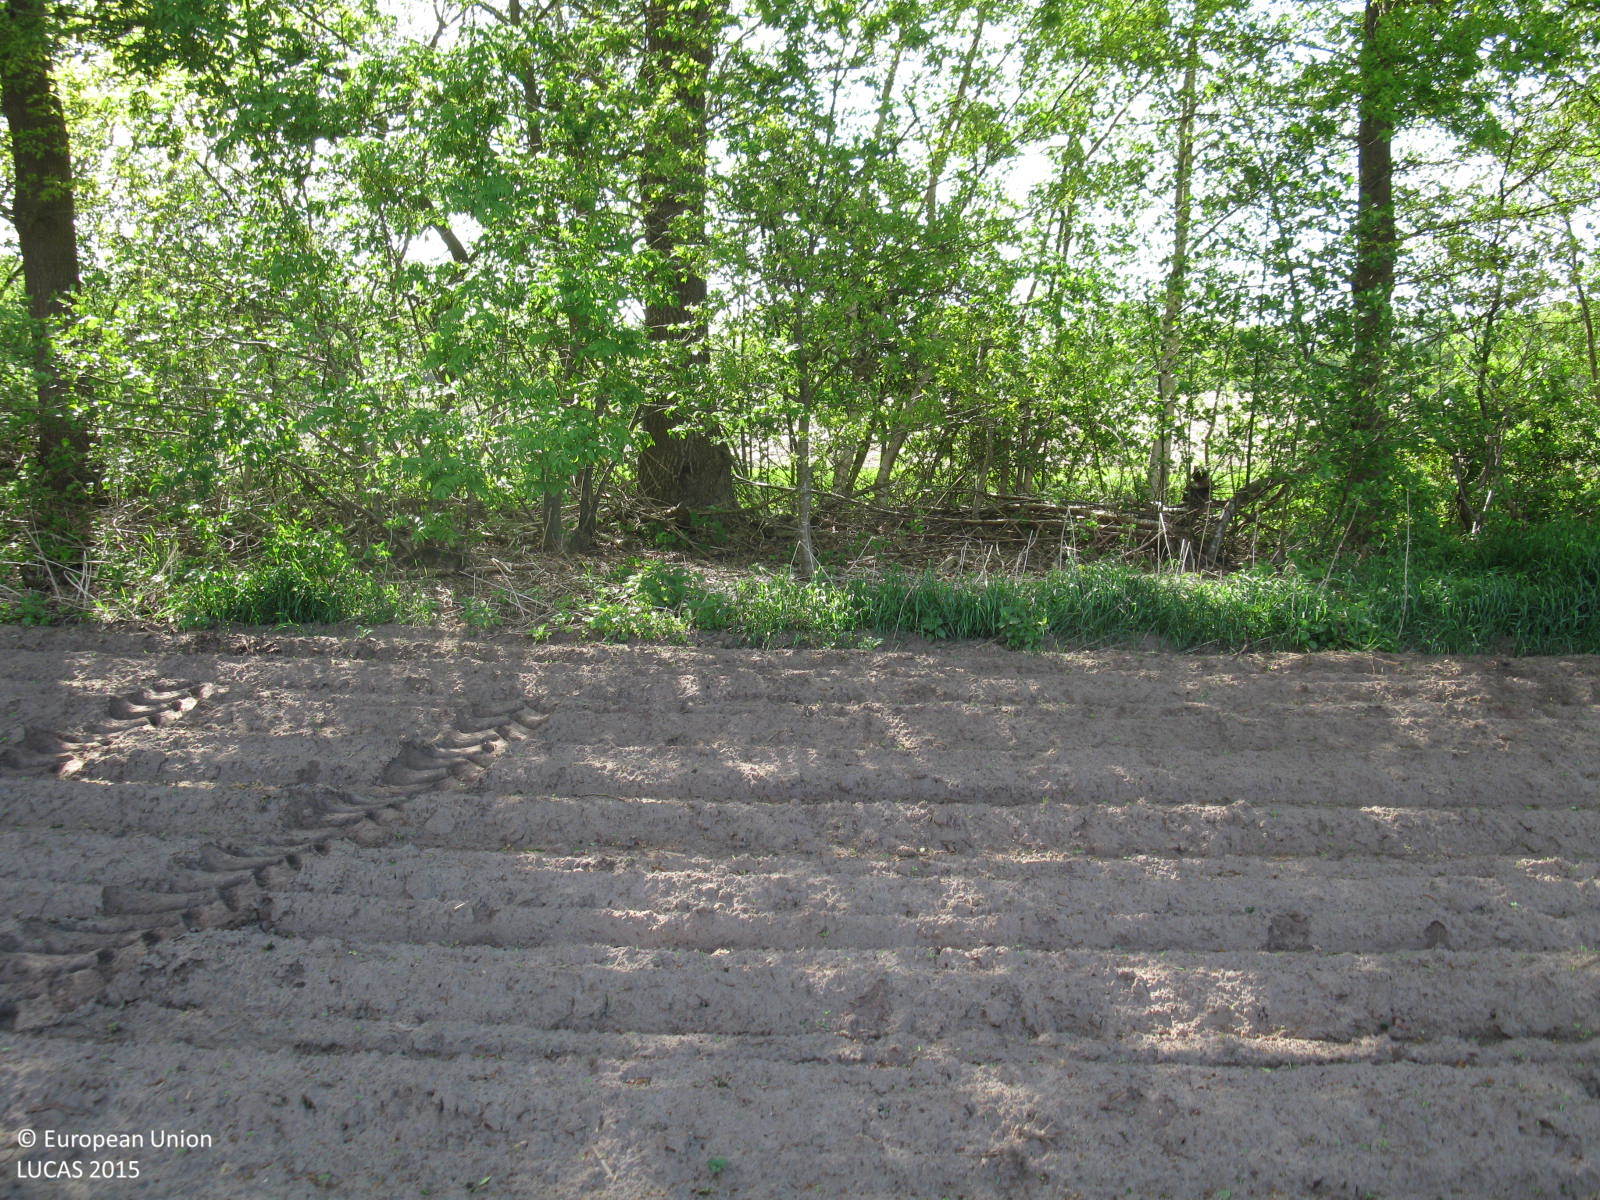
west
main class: Cropland
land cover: Potatoes
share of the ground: < 10 %
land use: Agriculture (excluding fallow land and kitchen gardens)
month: May
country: DE
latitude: 53.0136
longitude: 7.3623
